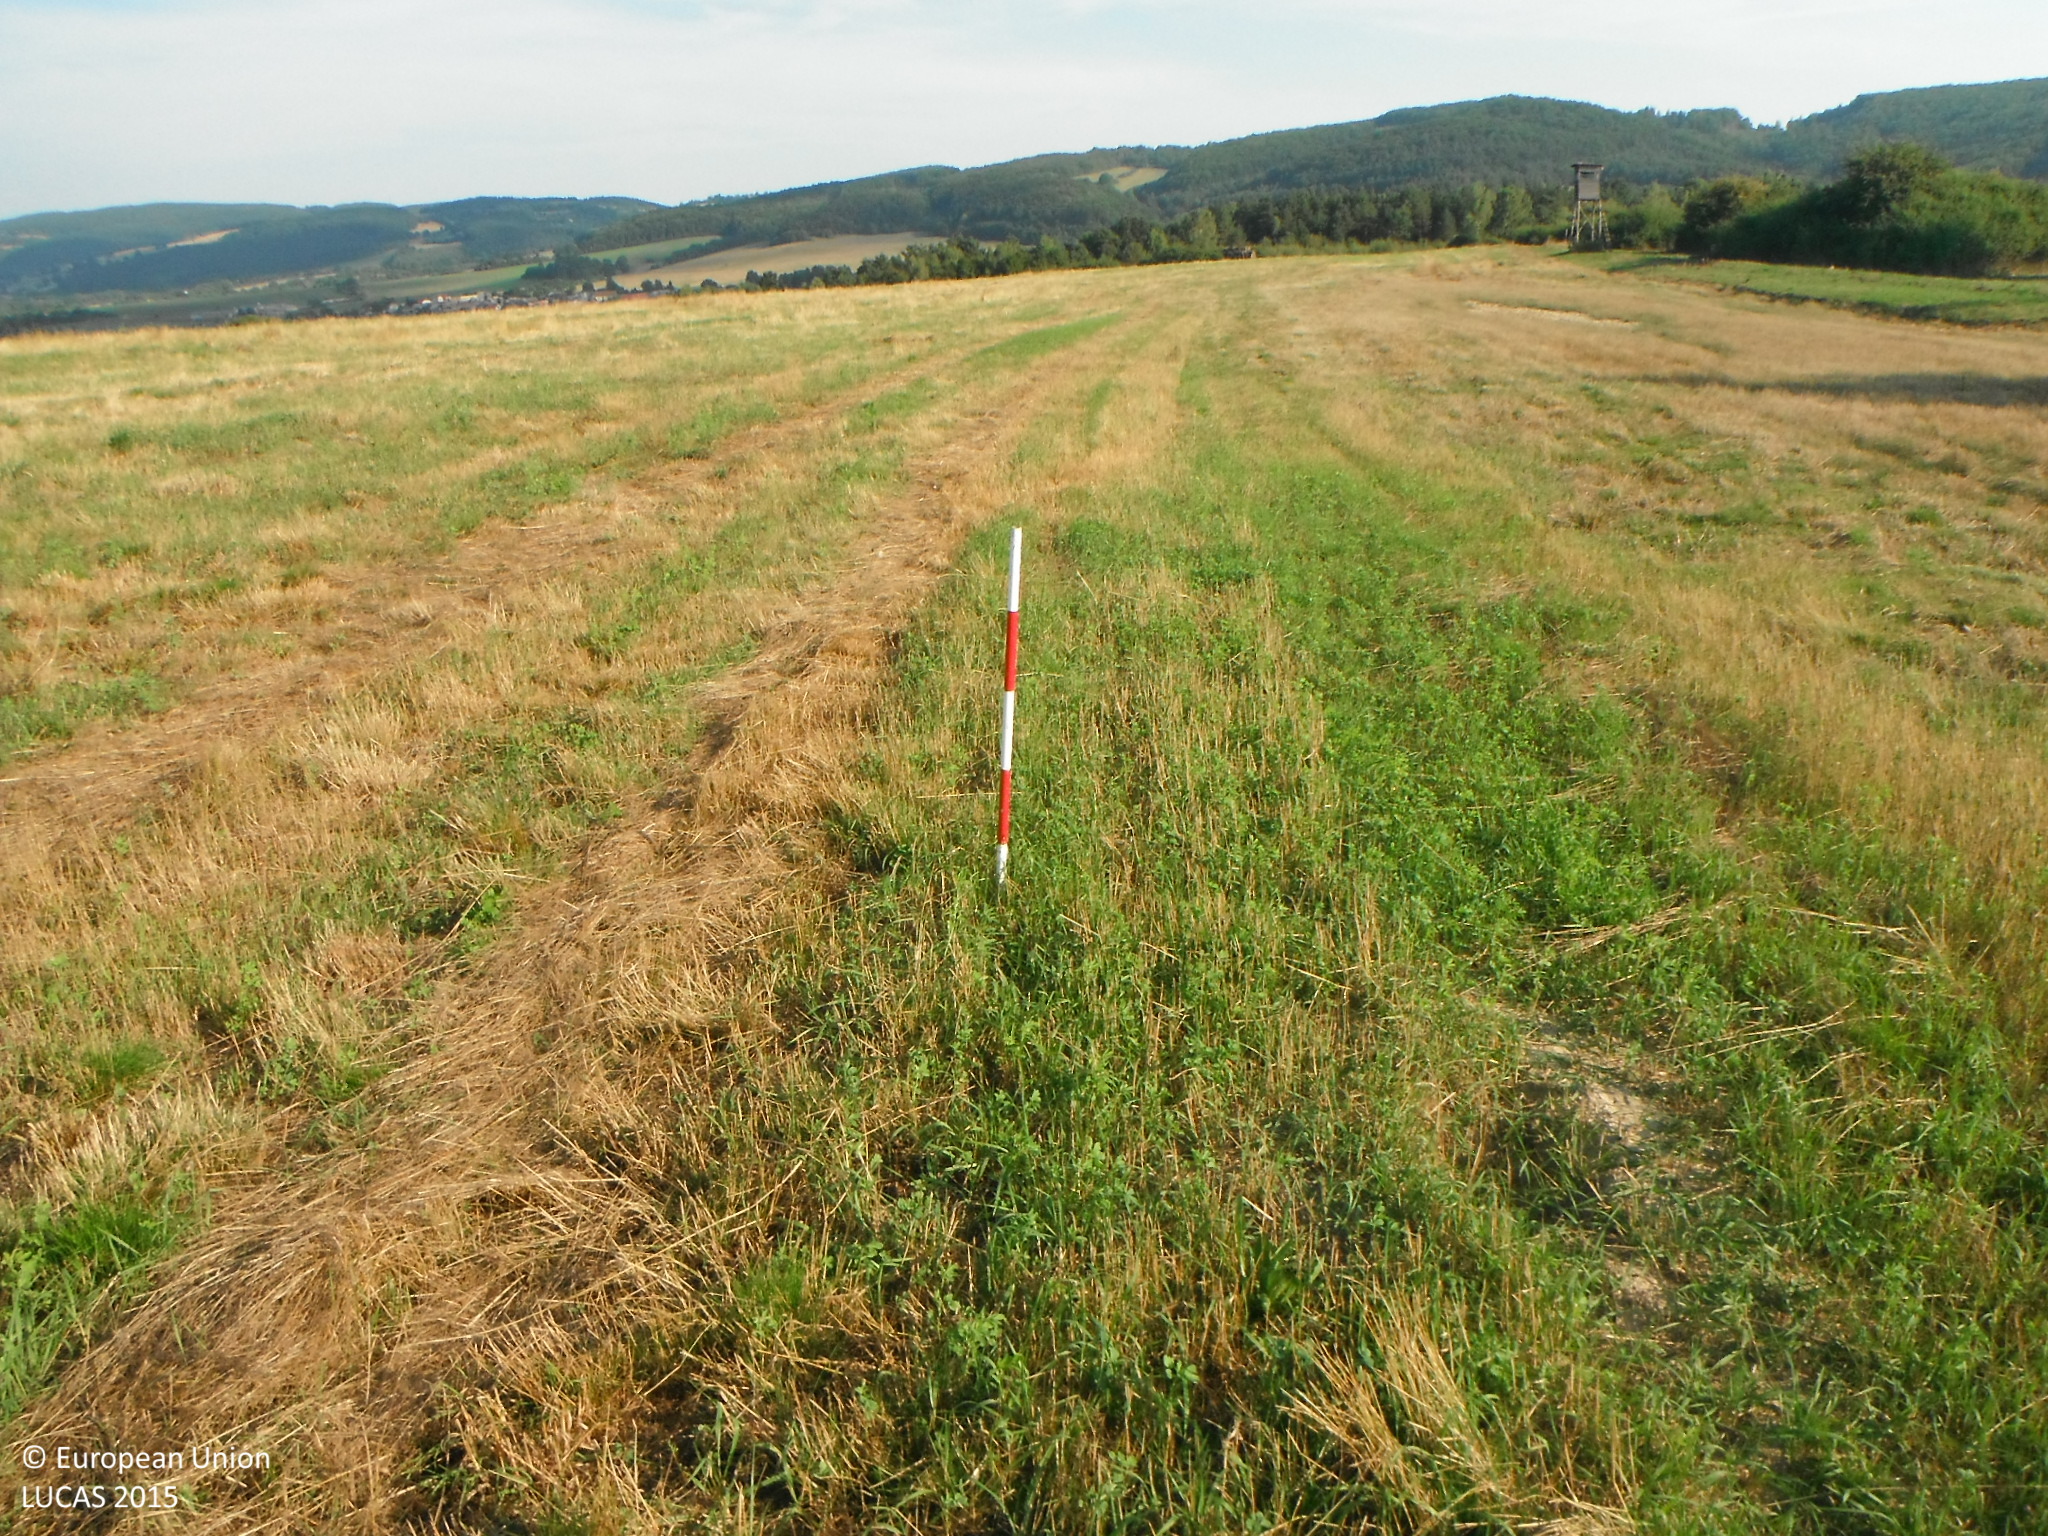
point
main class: Cropland
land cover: Other leguminous and mixtures for fodder
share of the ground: > 75 %
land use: Agriculture (excluding fallow land and kitchen gardens)
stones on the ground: < 10 %
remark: Harvested field
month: August
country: SK
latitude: 48.4246
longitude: 19.1160
